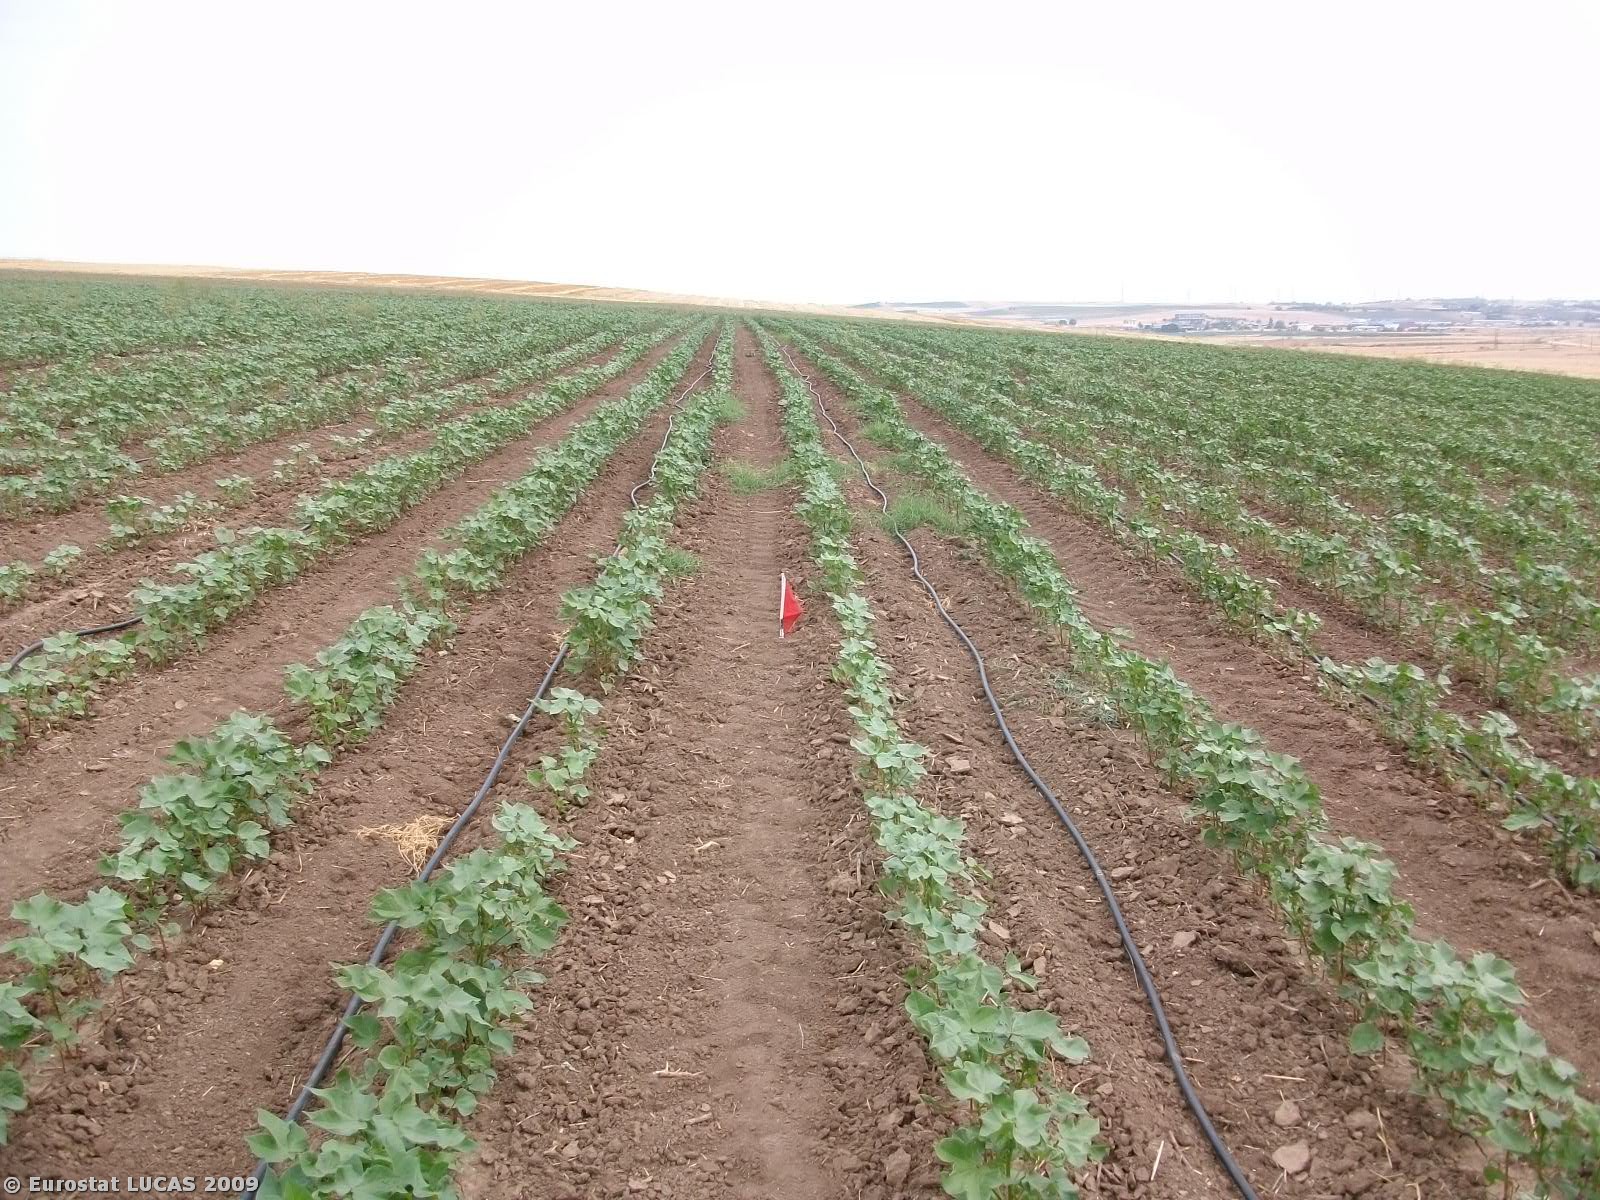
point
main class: Cropland
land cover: Cotton
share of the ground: 10 - 25 %
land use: Agriculture (excluding fallow land and kitchen gardens)
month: April
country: GR
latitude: 39.5706
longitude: 22.3861
